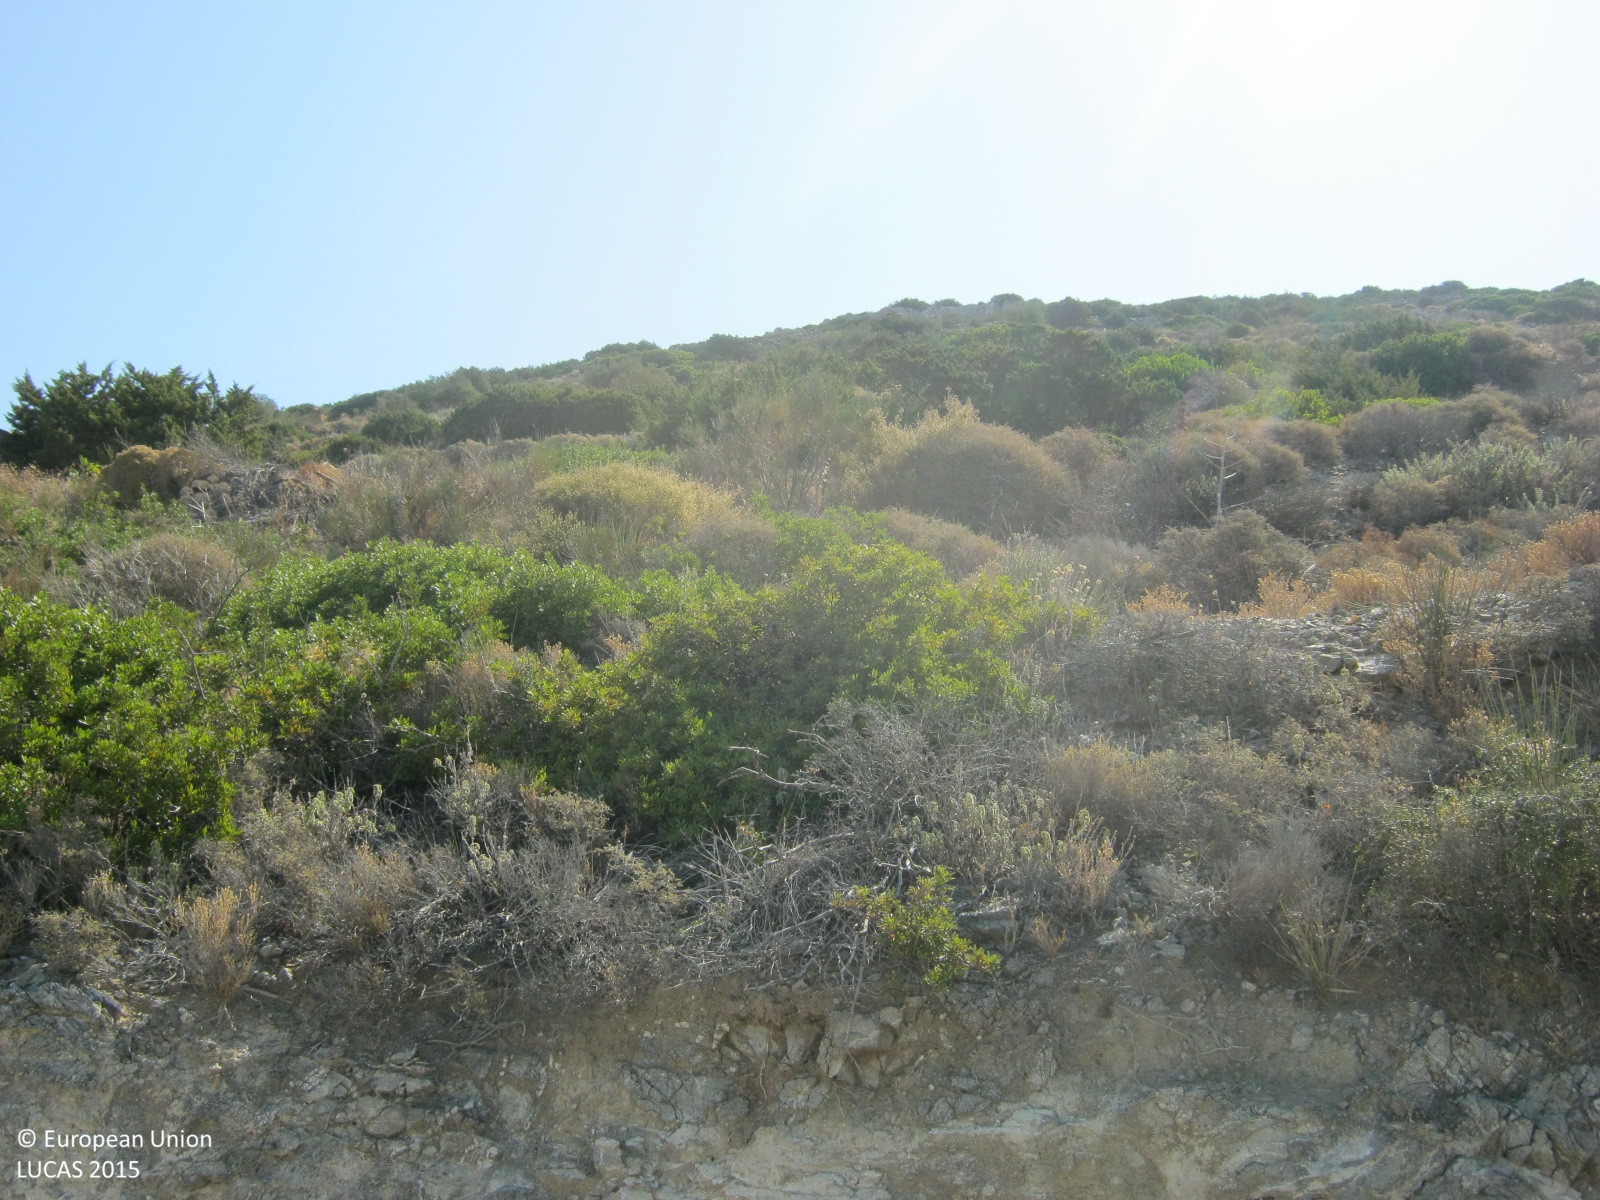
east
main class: Shrubland
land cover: Shrubland without tree cover
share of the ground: > 75 %
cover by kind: shrubs 80 %, herbaceous plants 10 %, unconsolidated bare surface 10 %
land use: Residential
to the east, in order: Shrubland without tree cover; Tracks; Shrubland without tree cover; Dry stone walls; Olive groves; Dry stone walls; Olive groves; Dry stone walls; Olive groves; Shrubland without tree cover; Dry stone walls; Shrubland without tree cover; Dry stone walls; Shrubland without tree cover
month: August
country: GR
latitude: 37.0915
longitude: 25.1829
